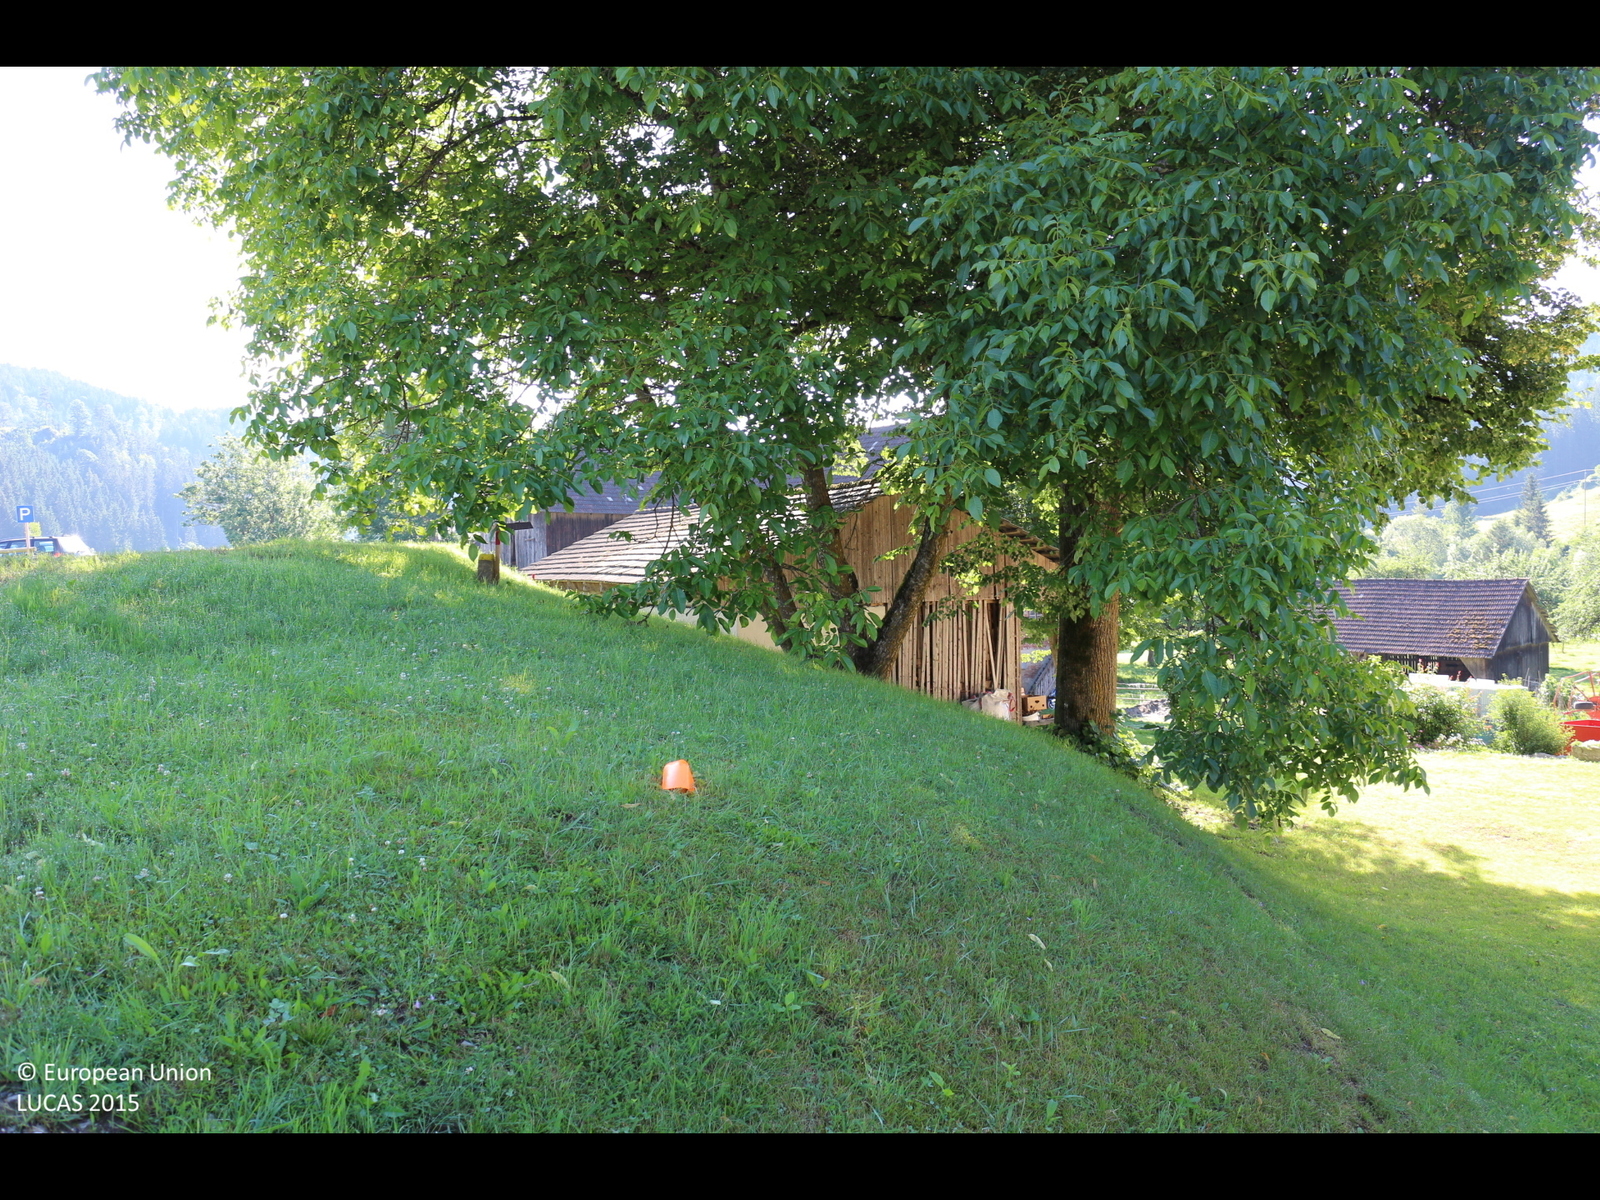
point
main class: Grassland
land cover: Grassland with sparse tree/shrub cover
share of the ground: > 75 %
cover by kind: herbaceous plants 95 %, broadleaved forest trees 5 %
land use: Agriculture (excluding fallow land and kitchen gardens)
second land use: Residential
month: June
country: AT
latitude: 46.8625
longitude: 14.2348
